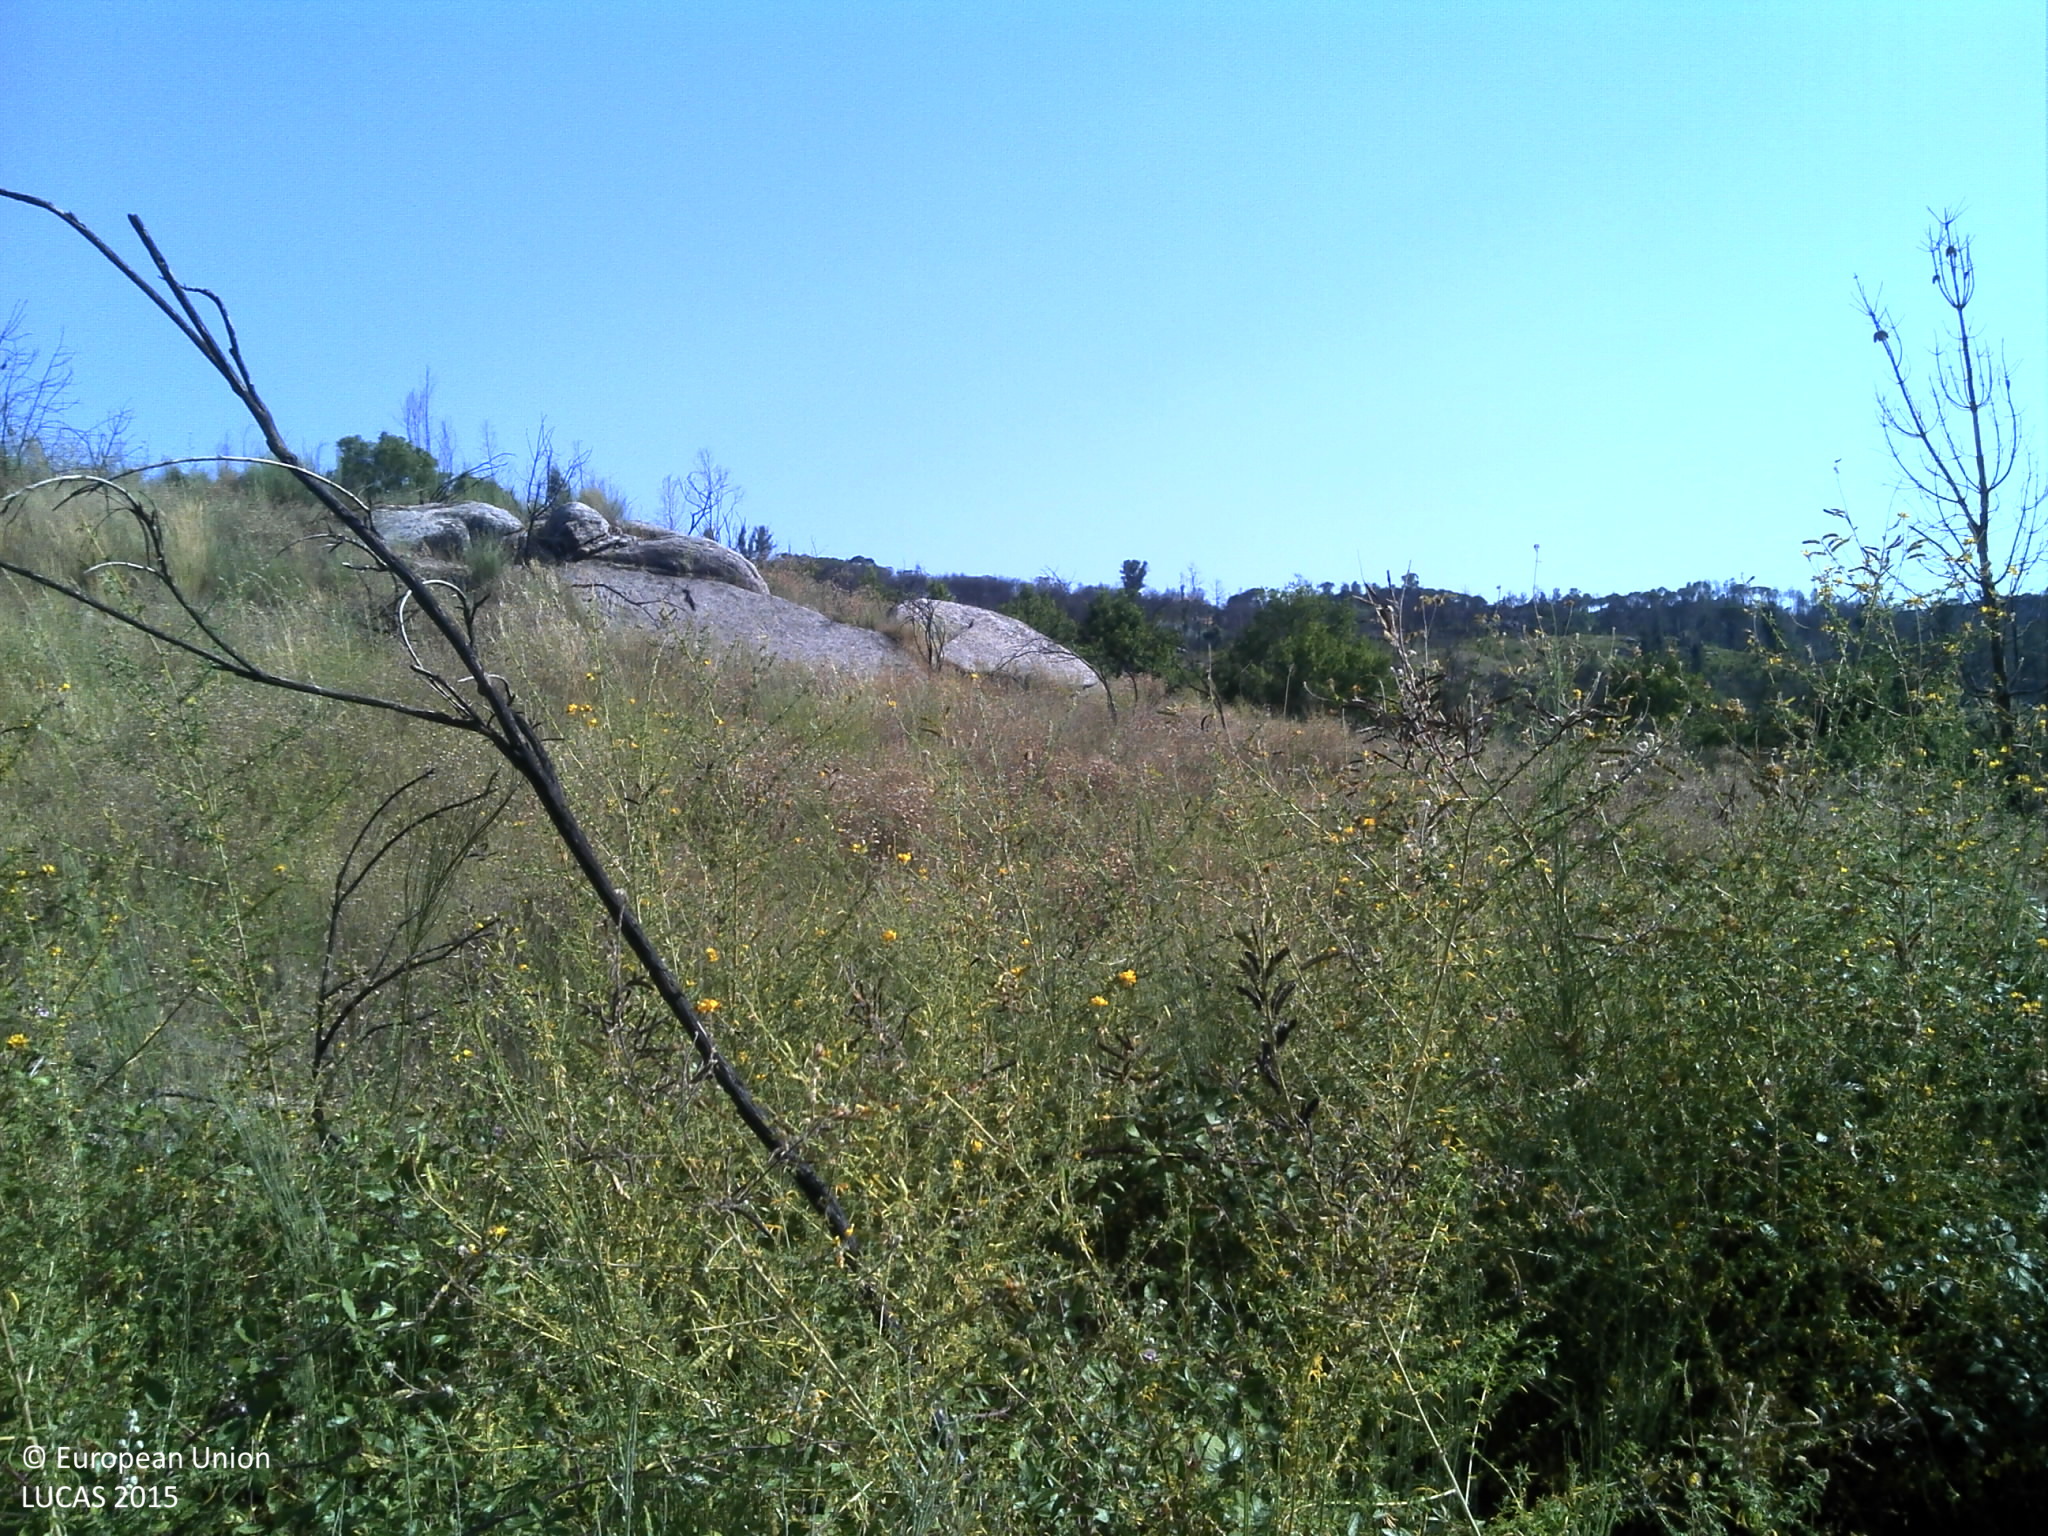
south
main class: Shrubland
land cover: Shrubland without tree cover
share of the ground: > 75 %
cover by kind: shrubs 80 %, unconsolidated bare surface 15 %, consolidated bare surface 5 %
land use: Semi-natural and natural areas not in use
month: June
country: PT
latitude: 40.5601
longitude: -7.9211
